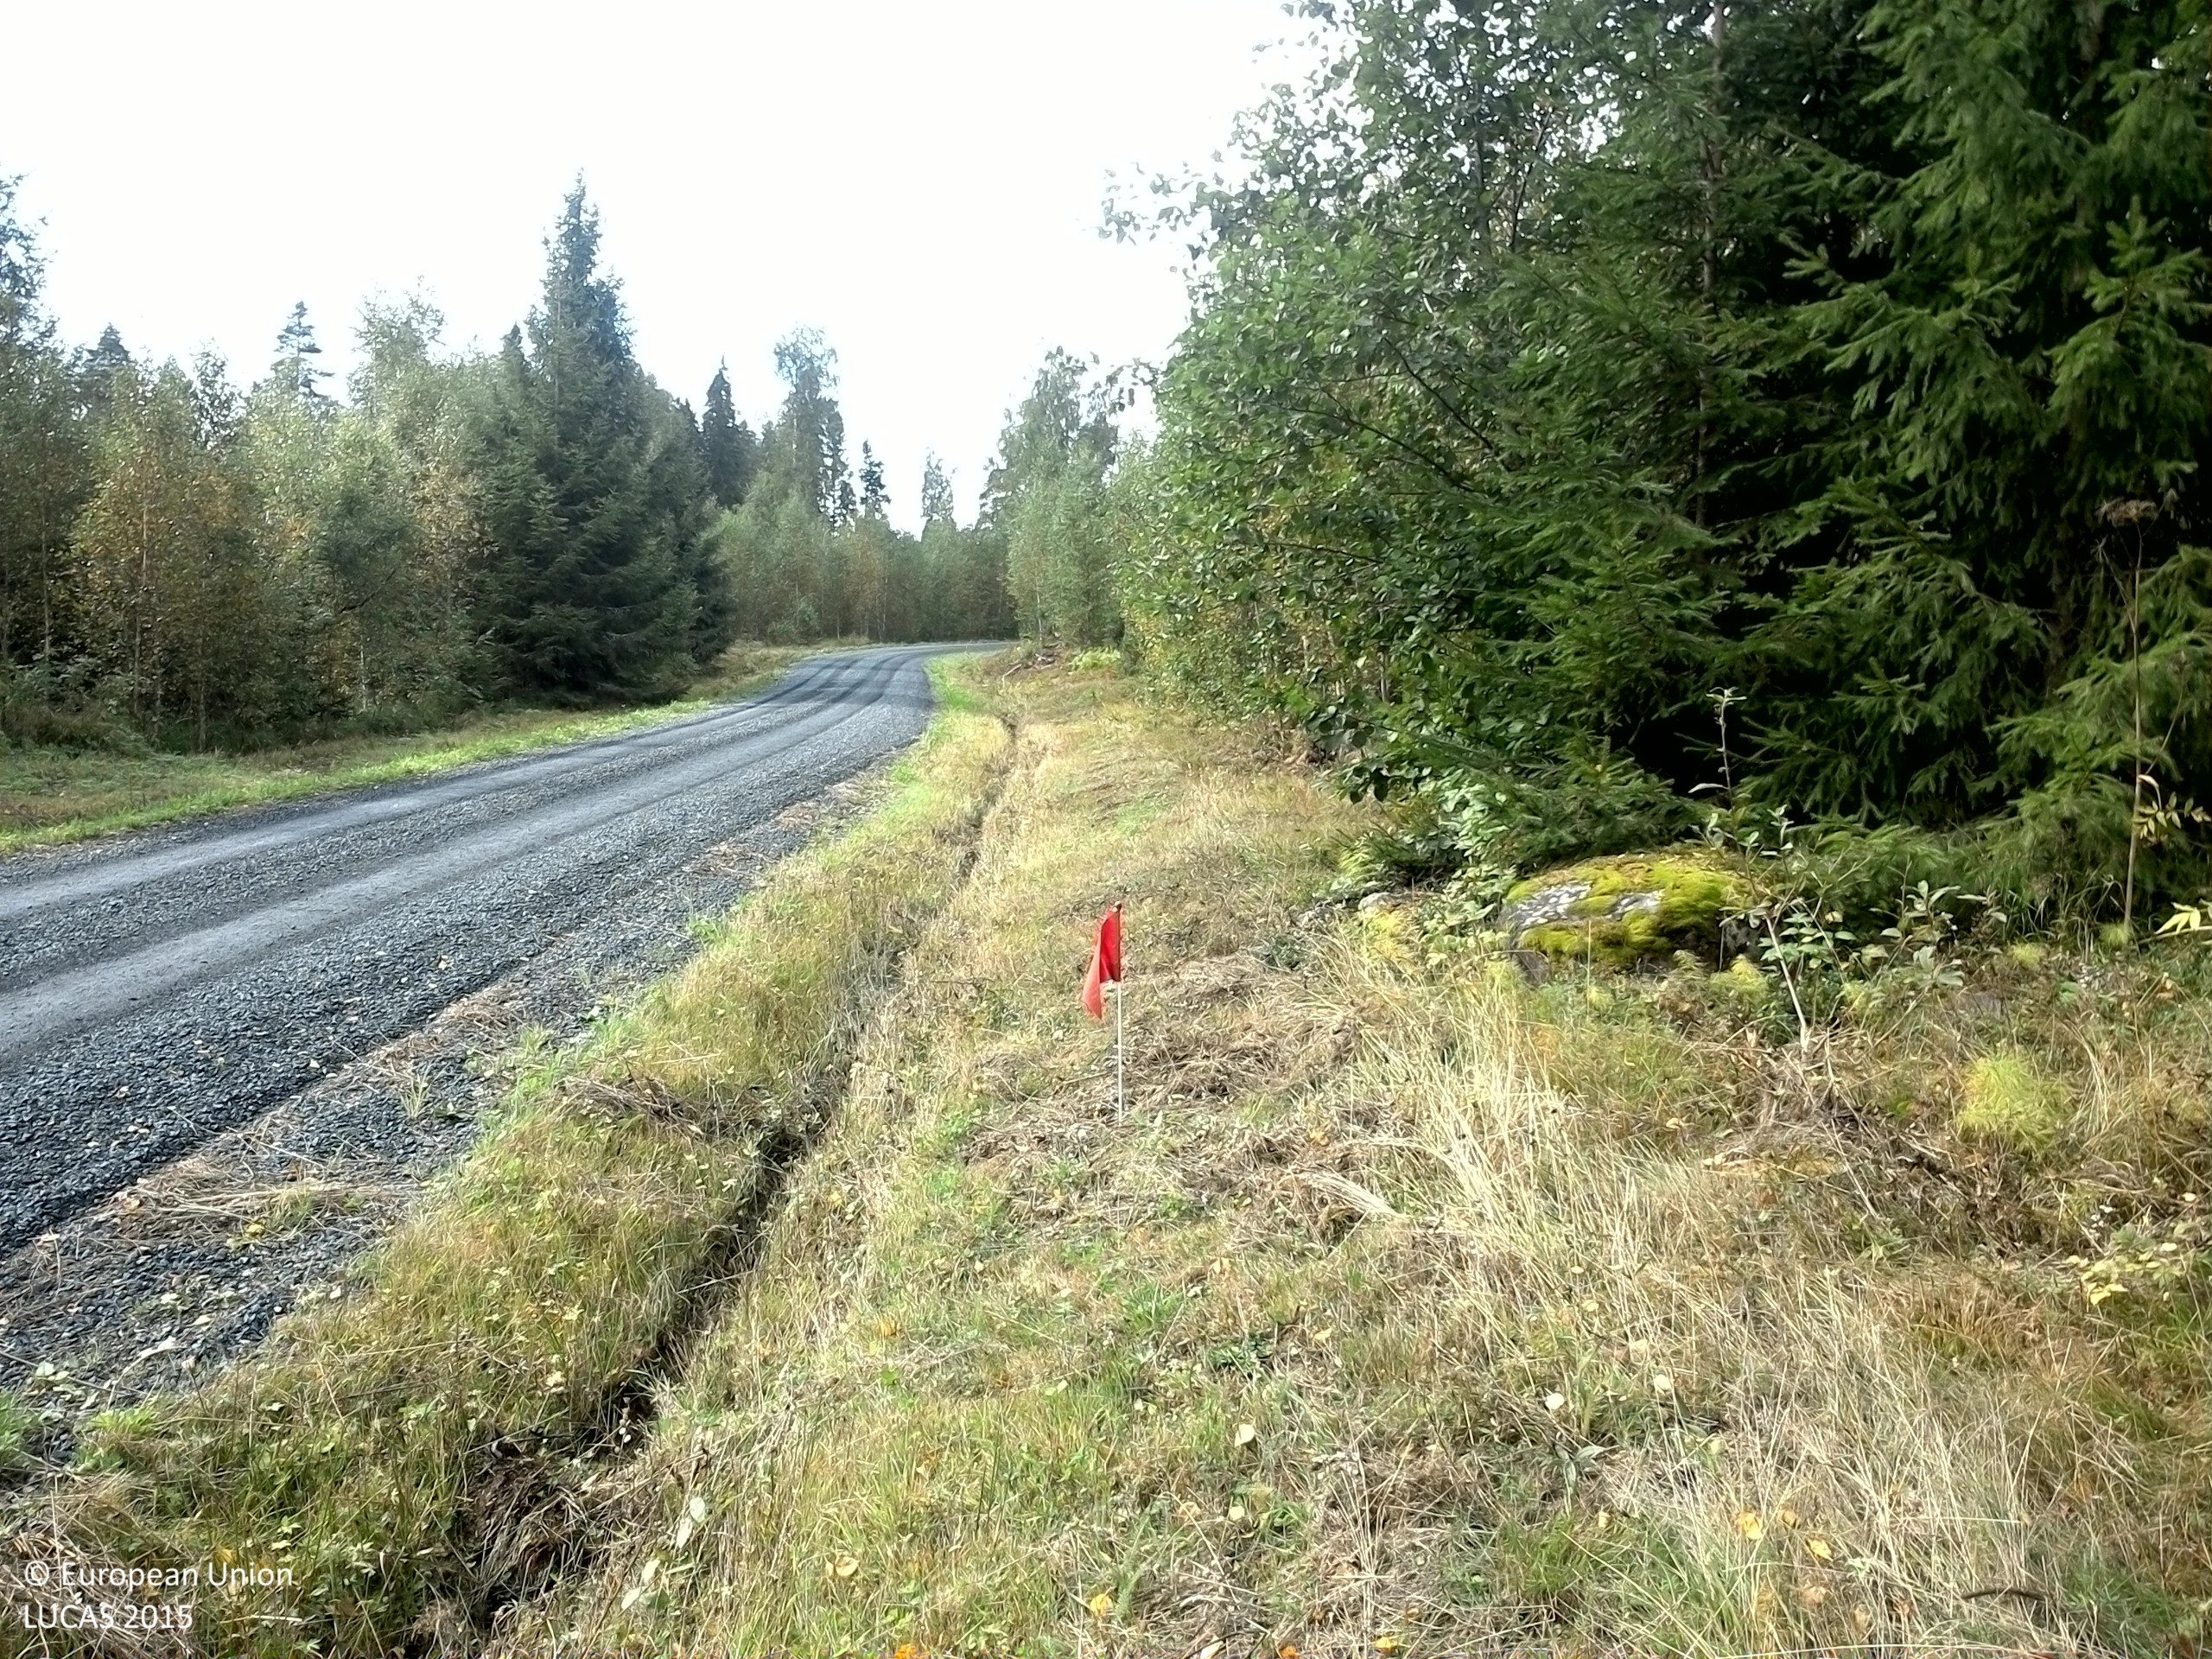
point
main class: Woodland
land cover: Spruce dominated mixed woodland
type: boreal forest
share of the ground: 25 - 50 %
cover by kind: coniferous forest trees 25 %, broadleaved forest trees 25 %, shrubs 20 %, herbaceous plants 15 %, lichens and mosses 15 %
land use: Forestry
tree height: > 5 m
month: September
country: SE
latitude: 59.9642
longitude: 13.1975
